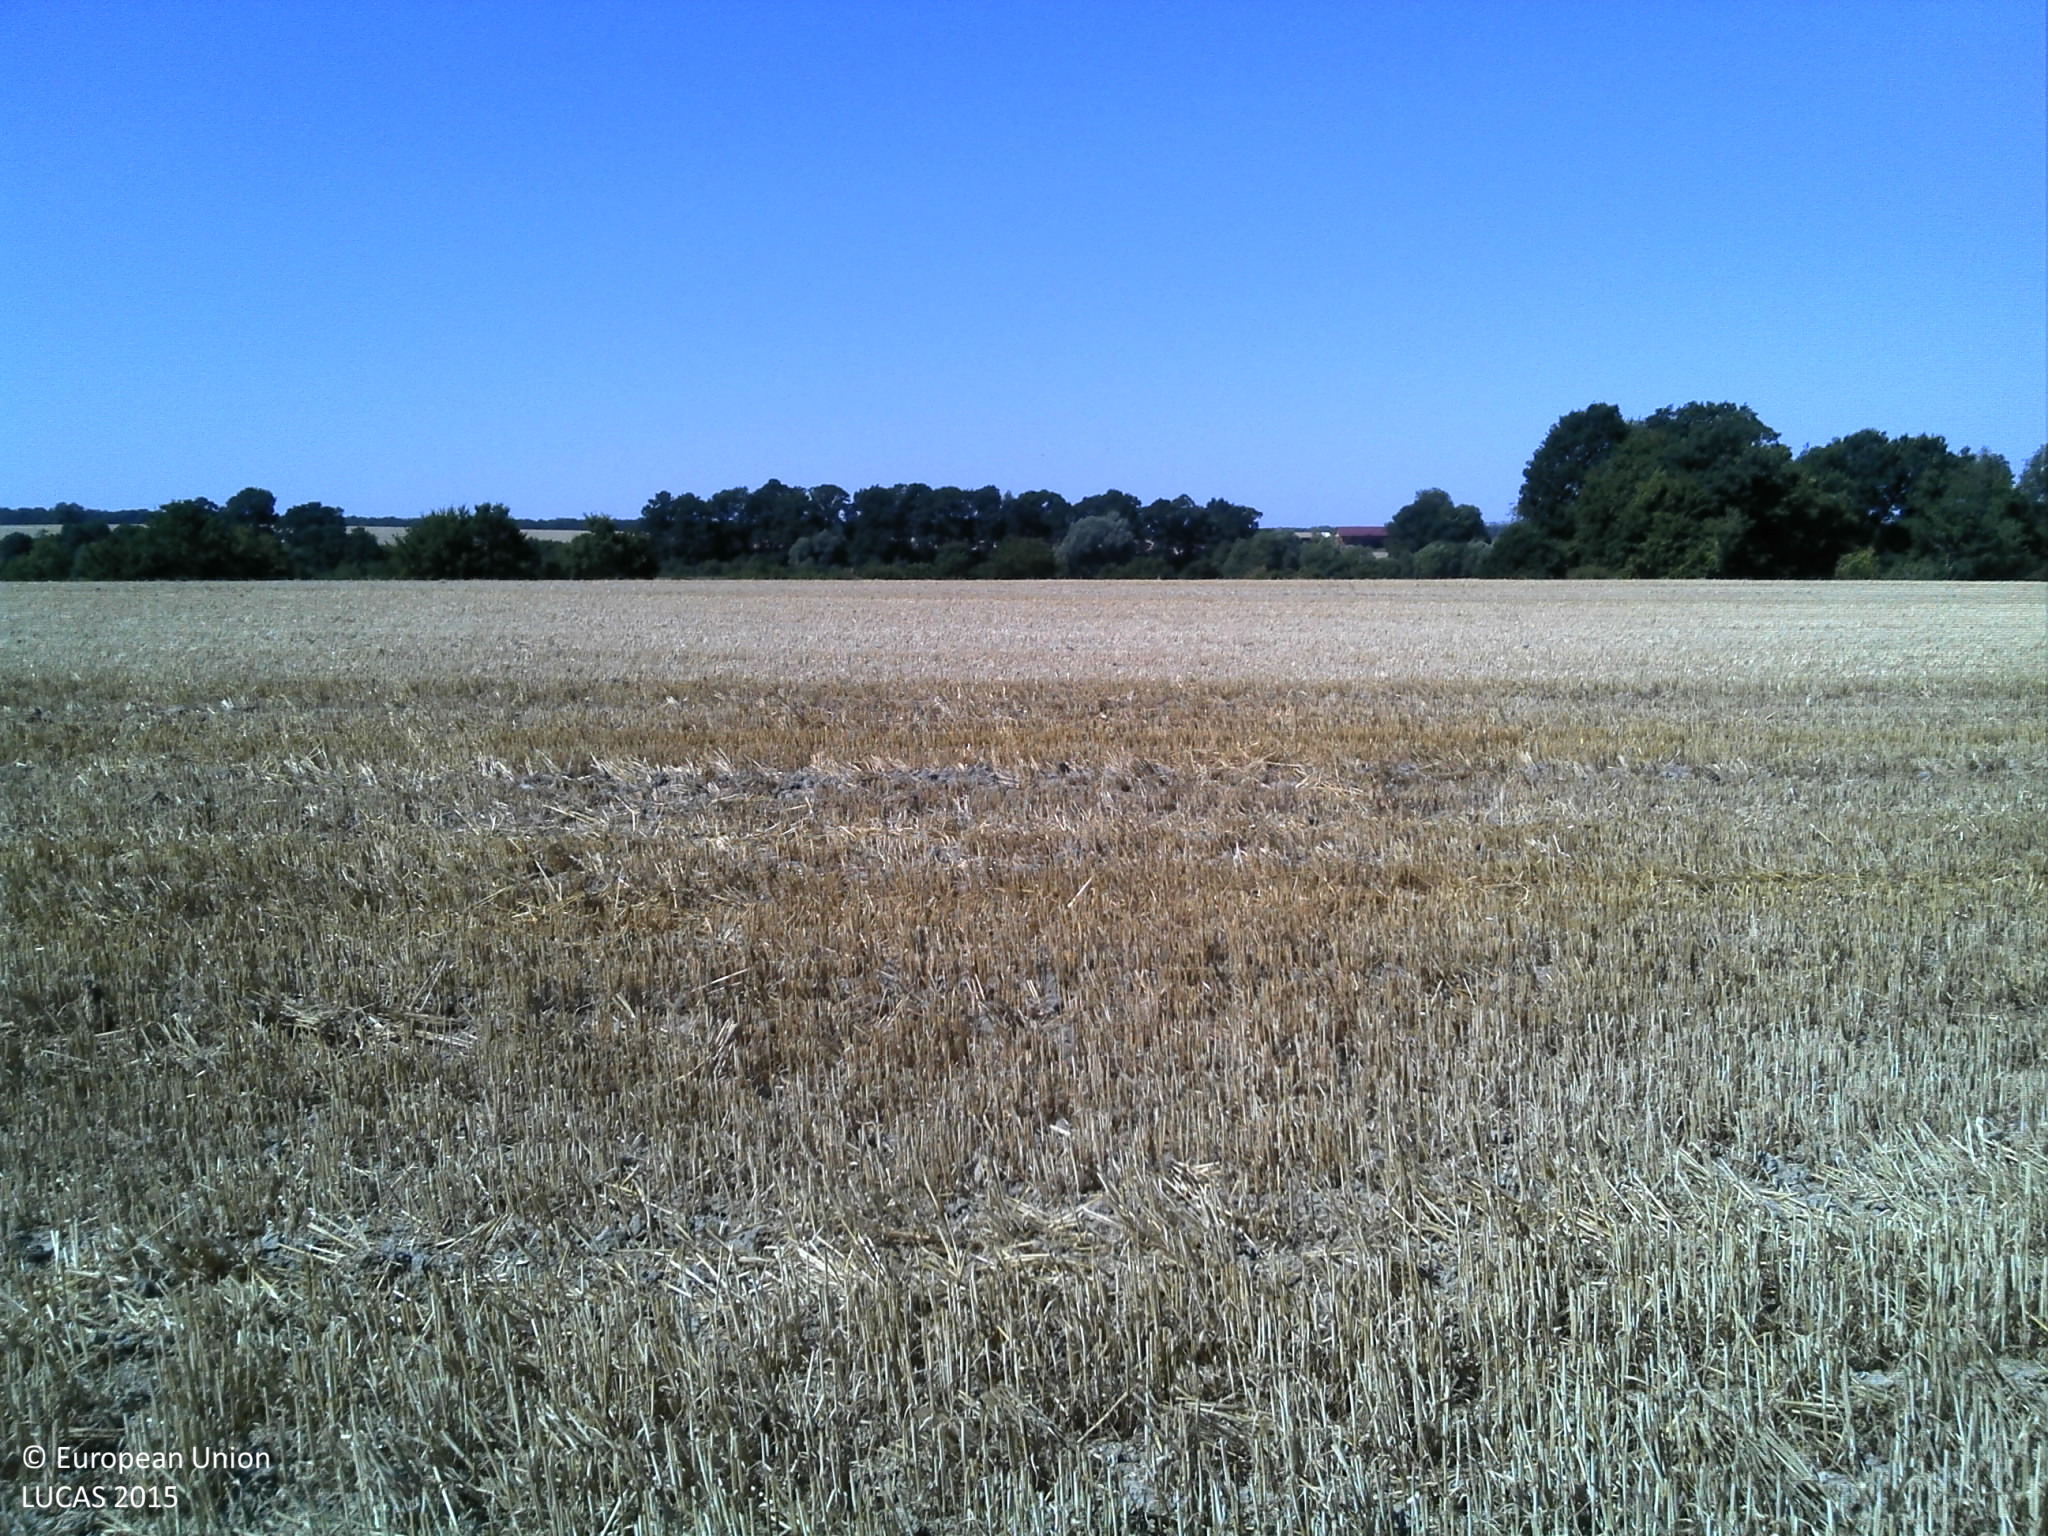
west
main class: Cropland
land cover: Common wheat
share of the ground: > 75 %
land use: Agriculture (excluding fallow land and kitchen gardens)
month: August
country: FR
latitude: 49.2029
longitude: 4.8506
